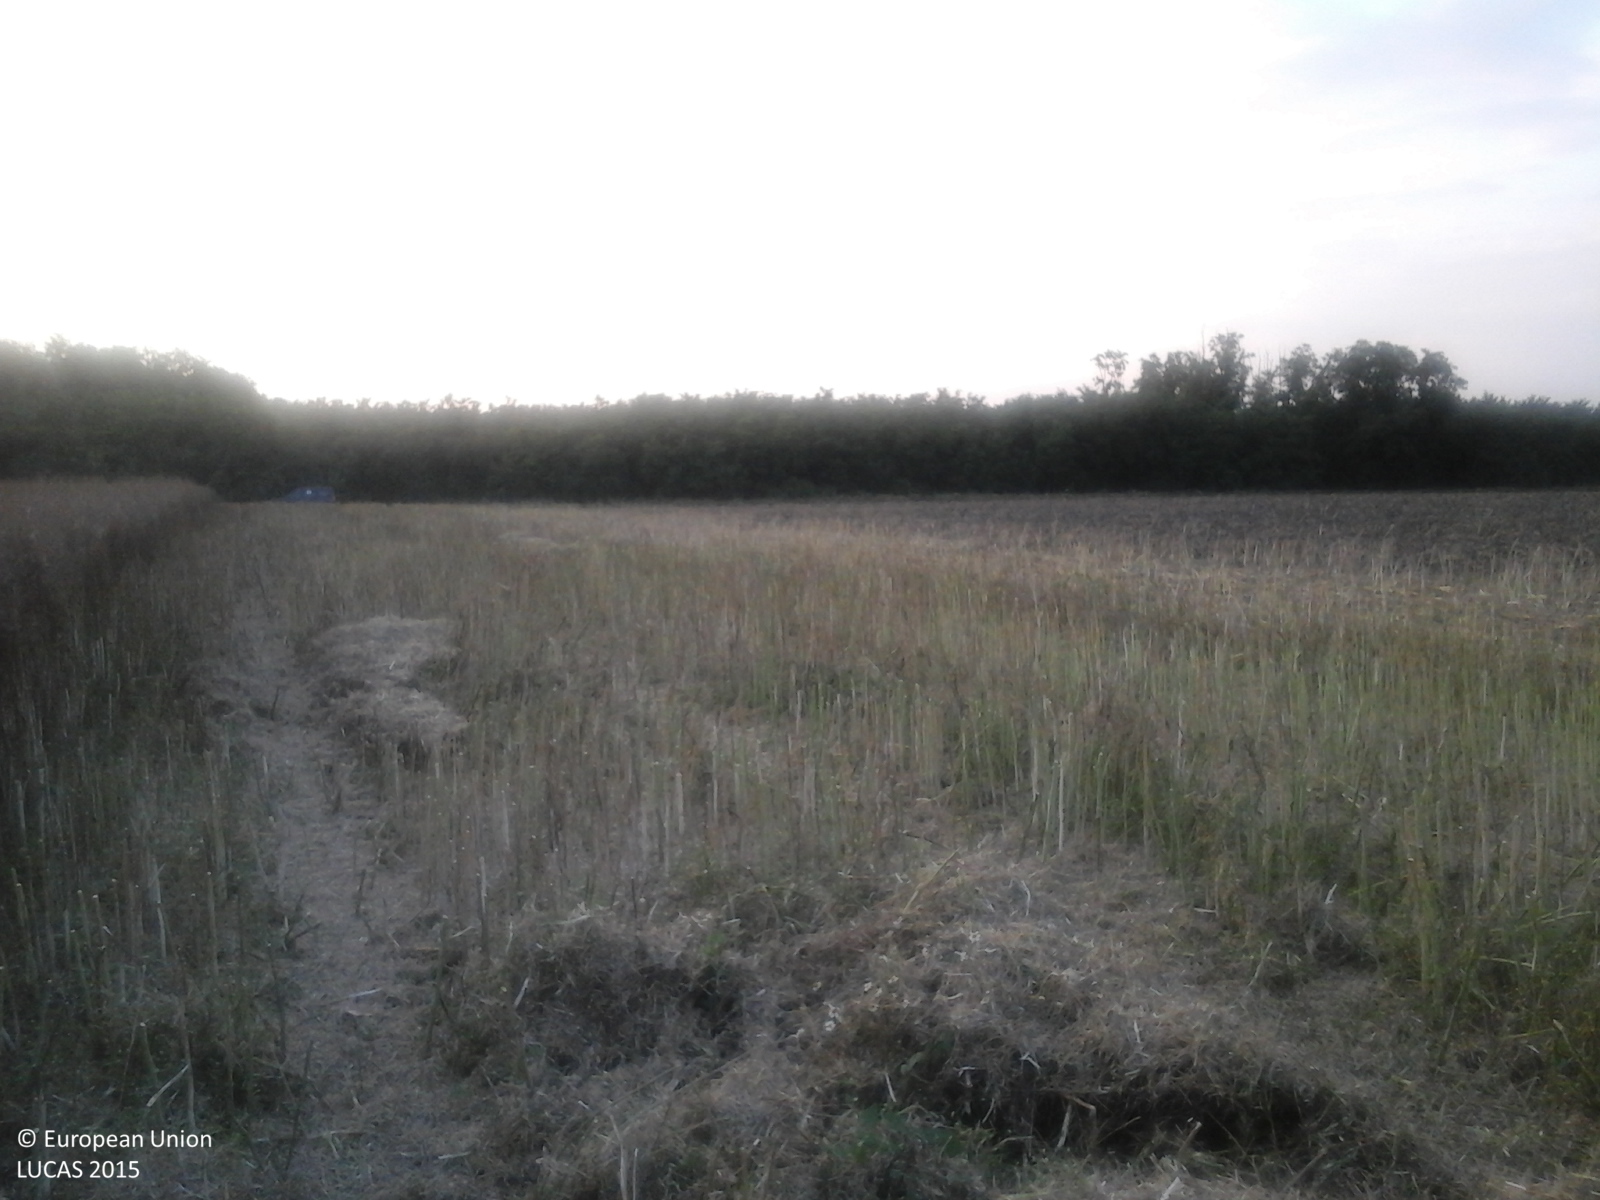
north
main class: Cropland
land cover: Rape and turnip rape
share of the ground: > 75 %
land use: Agriculture (excluding fallow land and kitchen gardens)
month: July
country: RO
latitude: 44.0359
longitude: 25.8809
